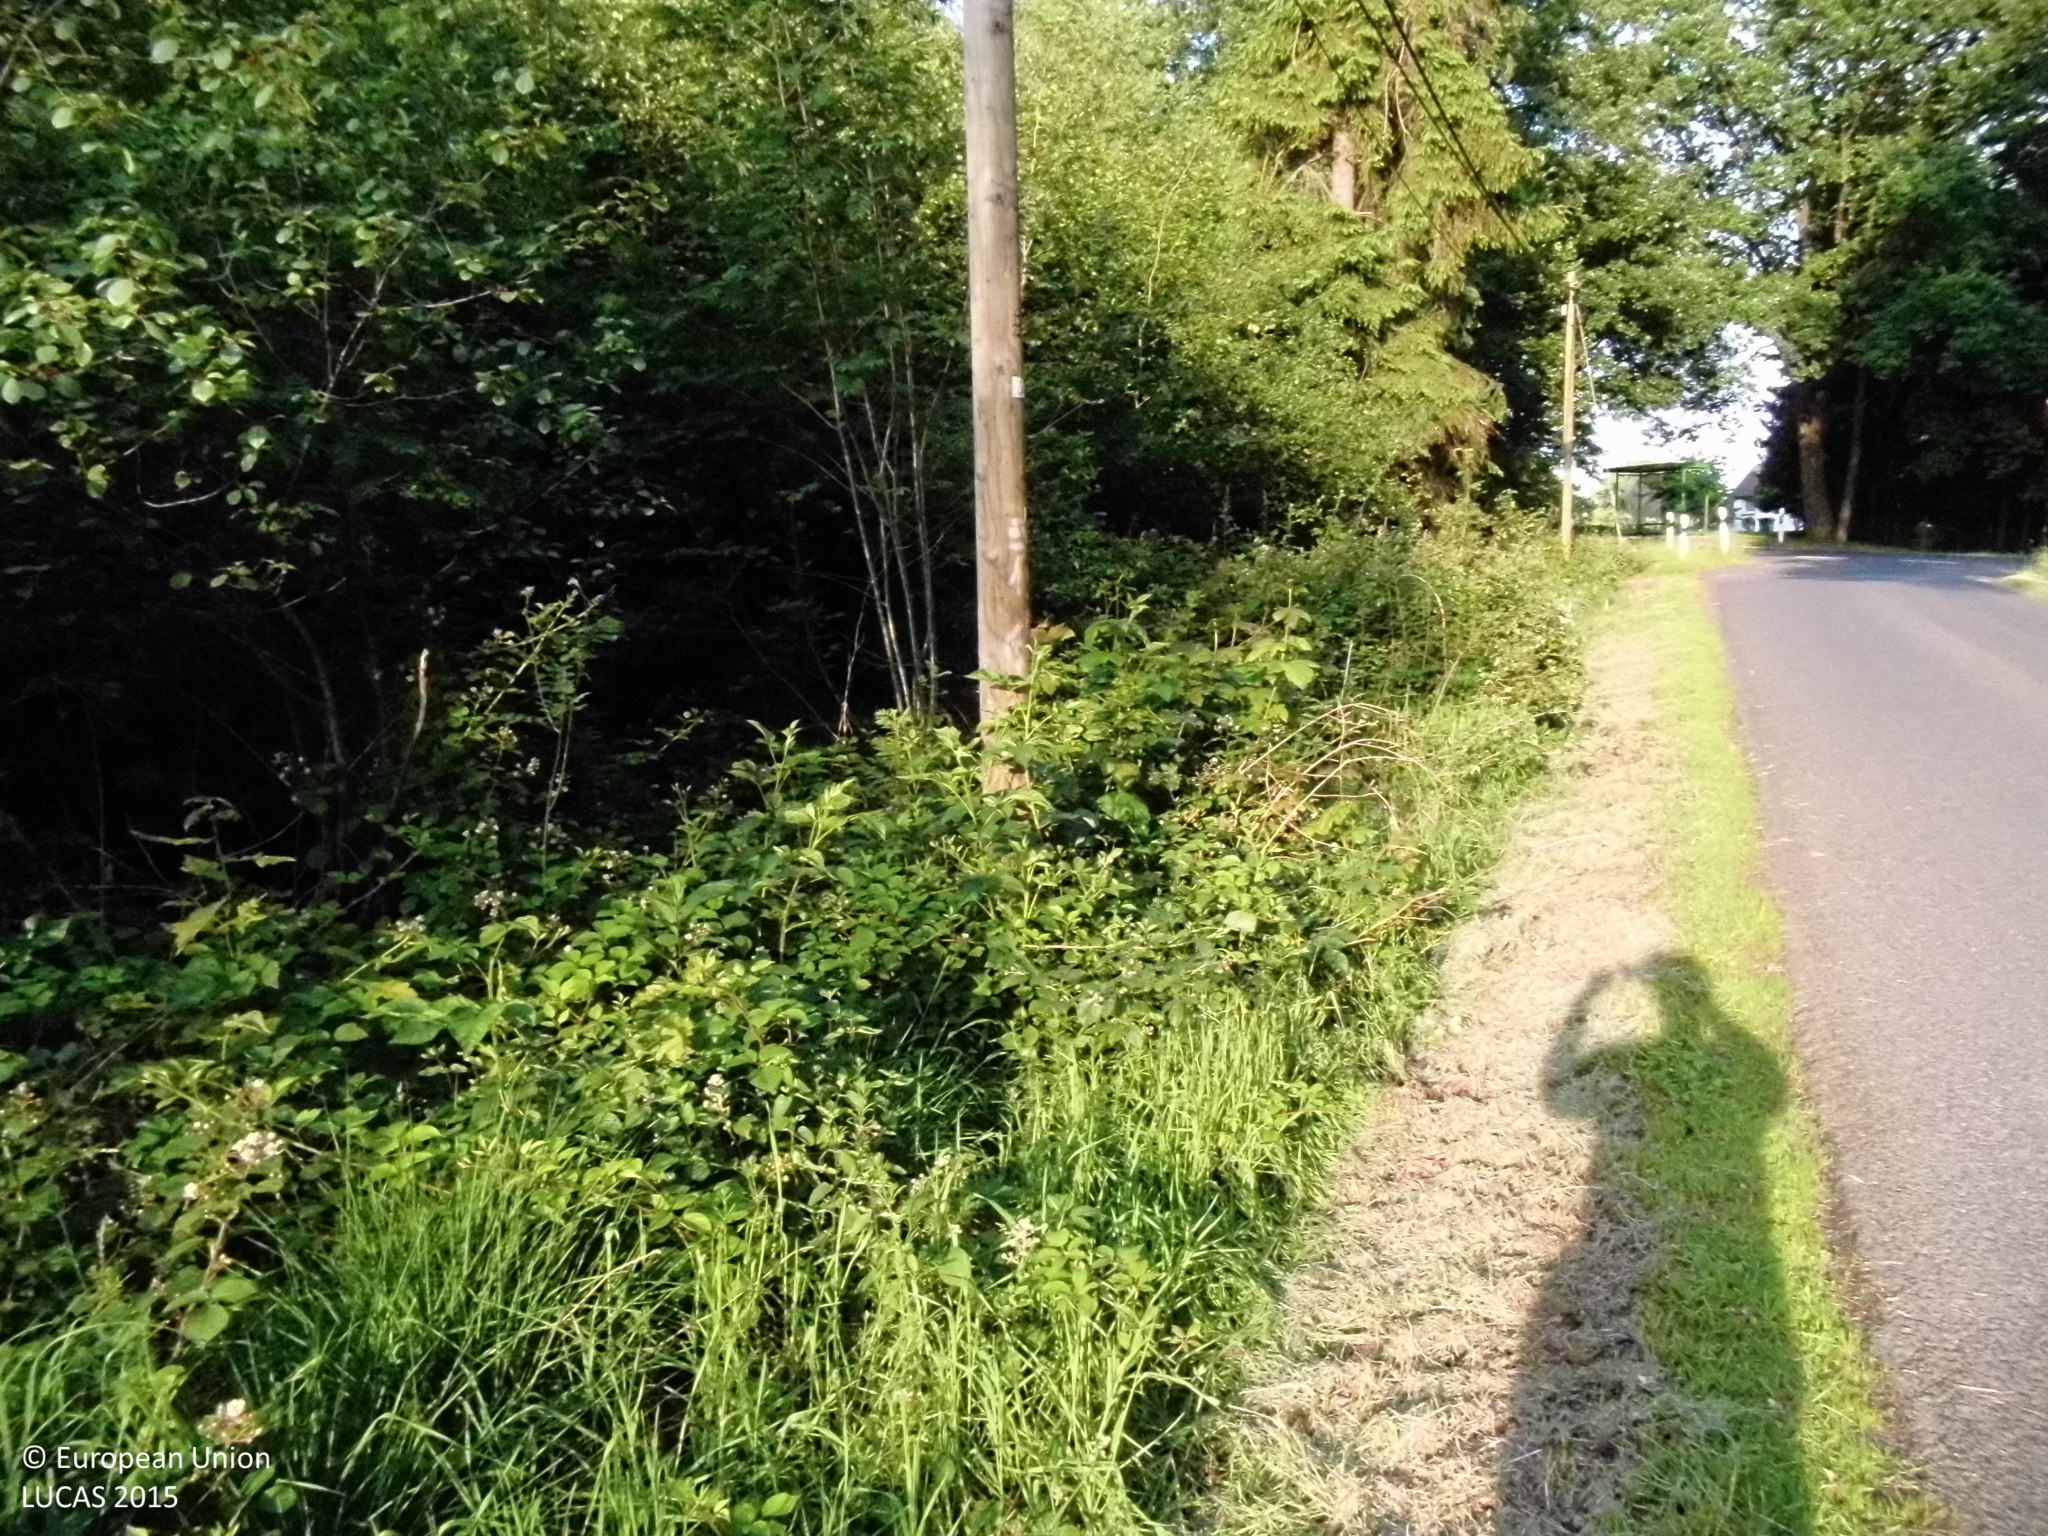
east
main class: Woodland
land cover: Broadleaved woodland
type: mesophytic deciduous forest
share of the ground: > 75 %
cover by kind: broadleaved forest trees 100 %
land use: Forestry
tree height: > 5 m
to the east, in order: Broadleaved woodland; Artificial constructions in urban areas; Grassland without tree/shrub cover
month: June
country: DE
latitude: 50.8222
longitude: 7.4876
